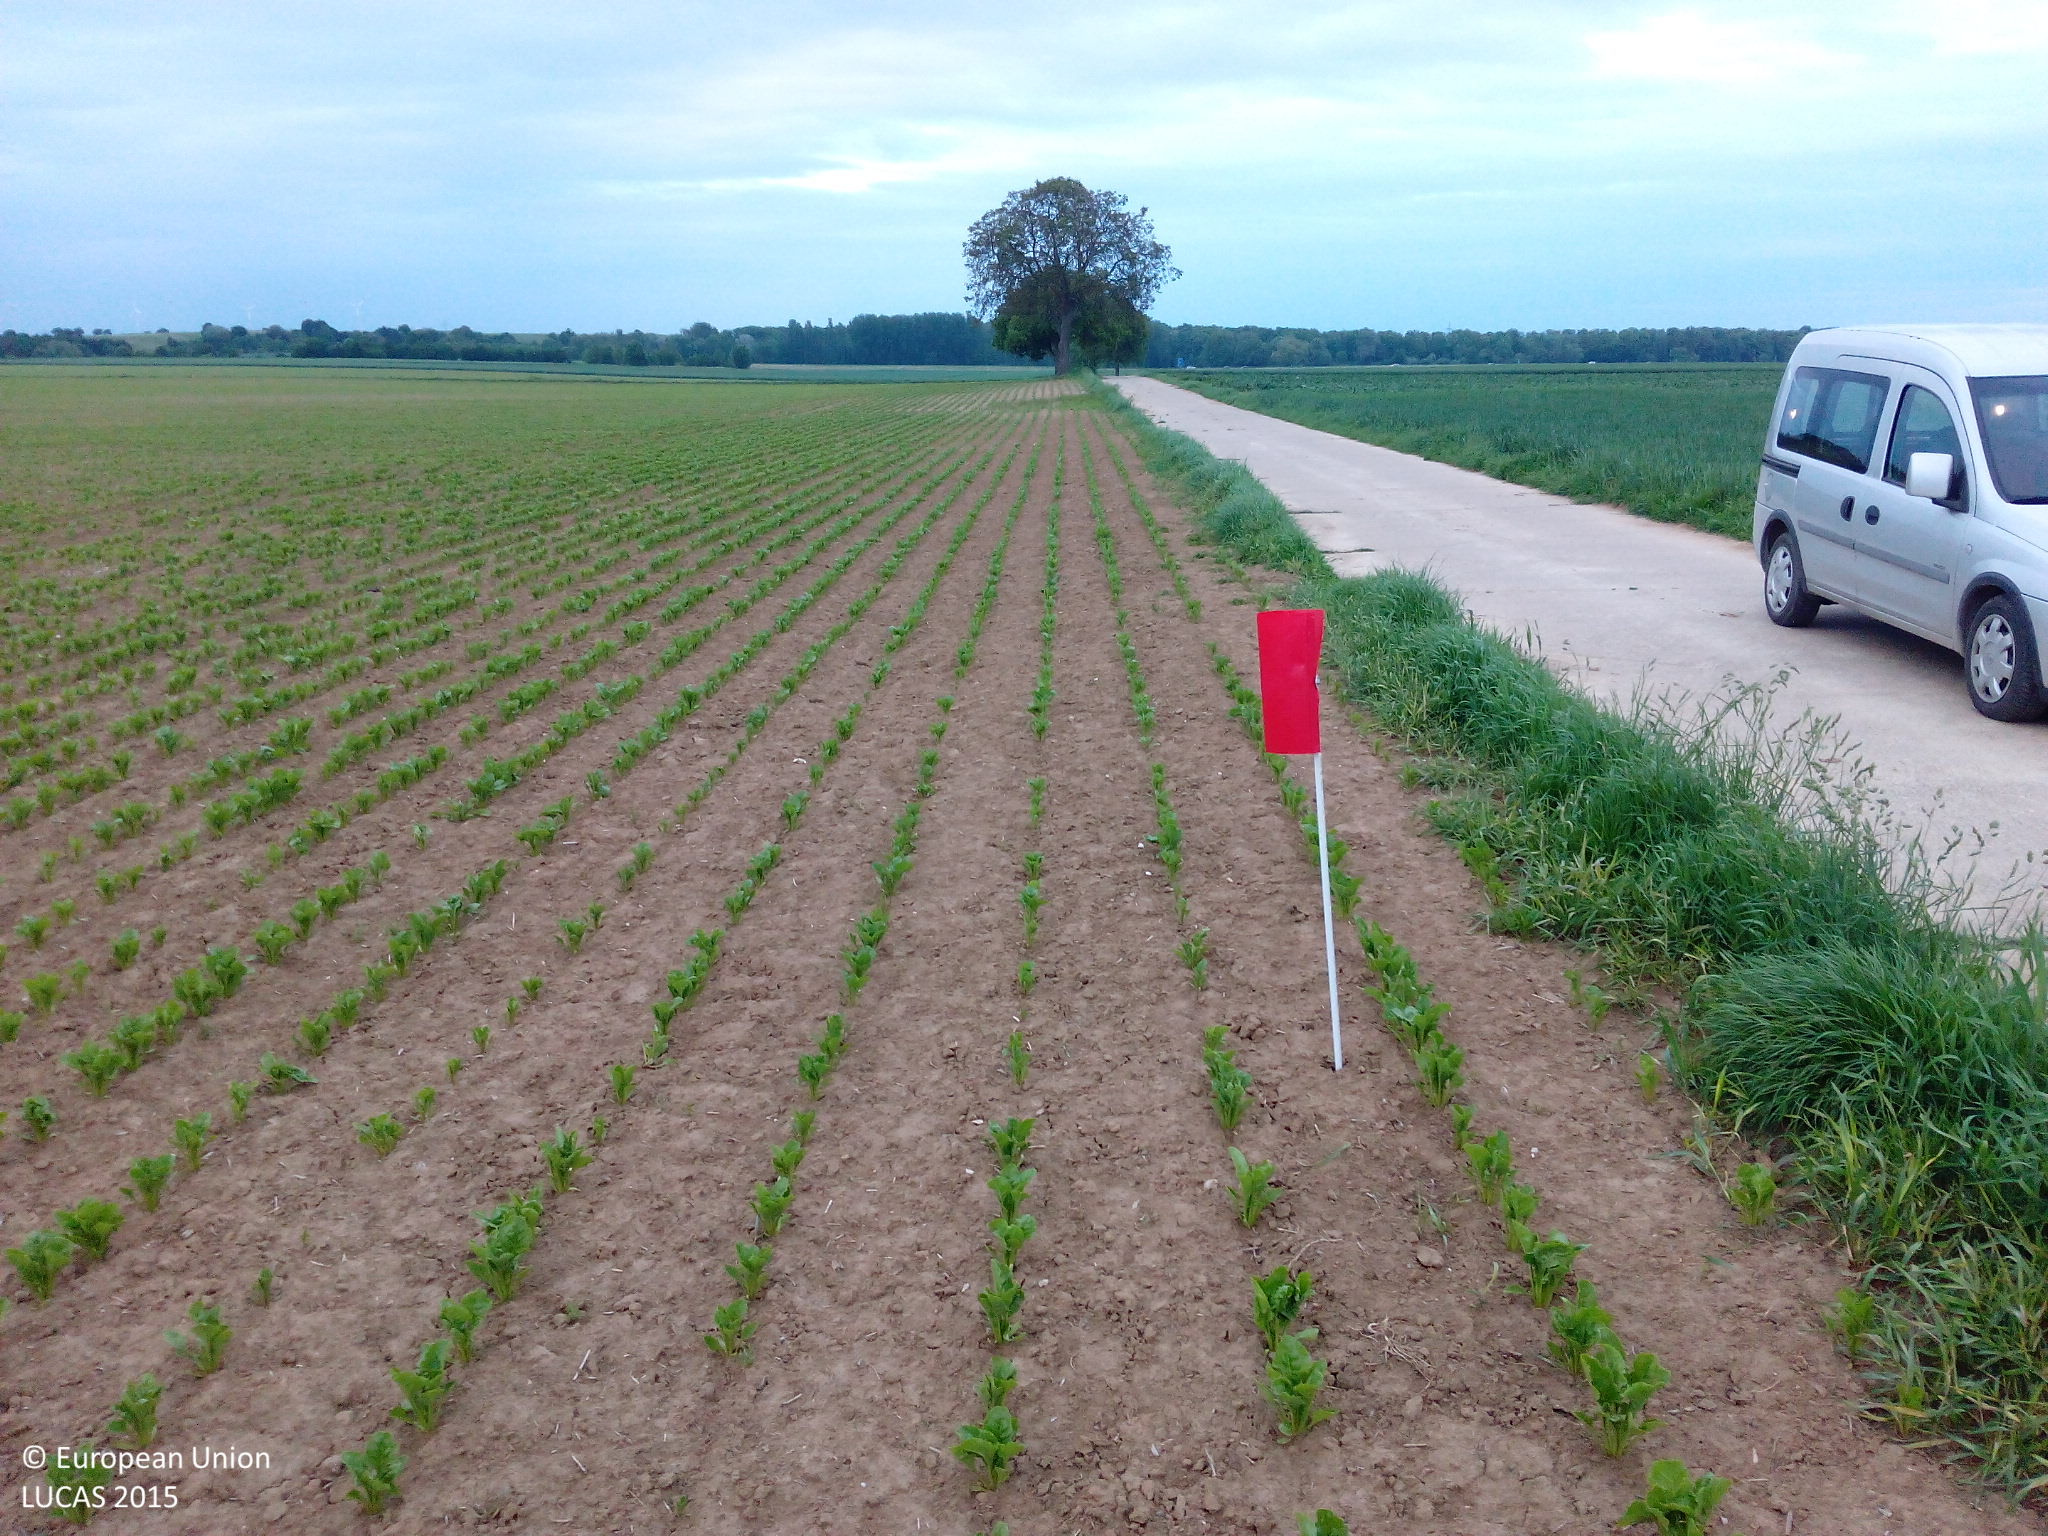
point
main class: Cropland
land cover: Sugar beet
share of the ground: < 10 %
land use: Agriculture (excluding fallow land and kitchen gardens)
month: May
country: DE
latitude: 49.1438
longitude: 8.1499
